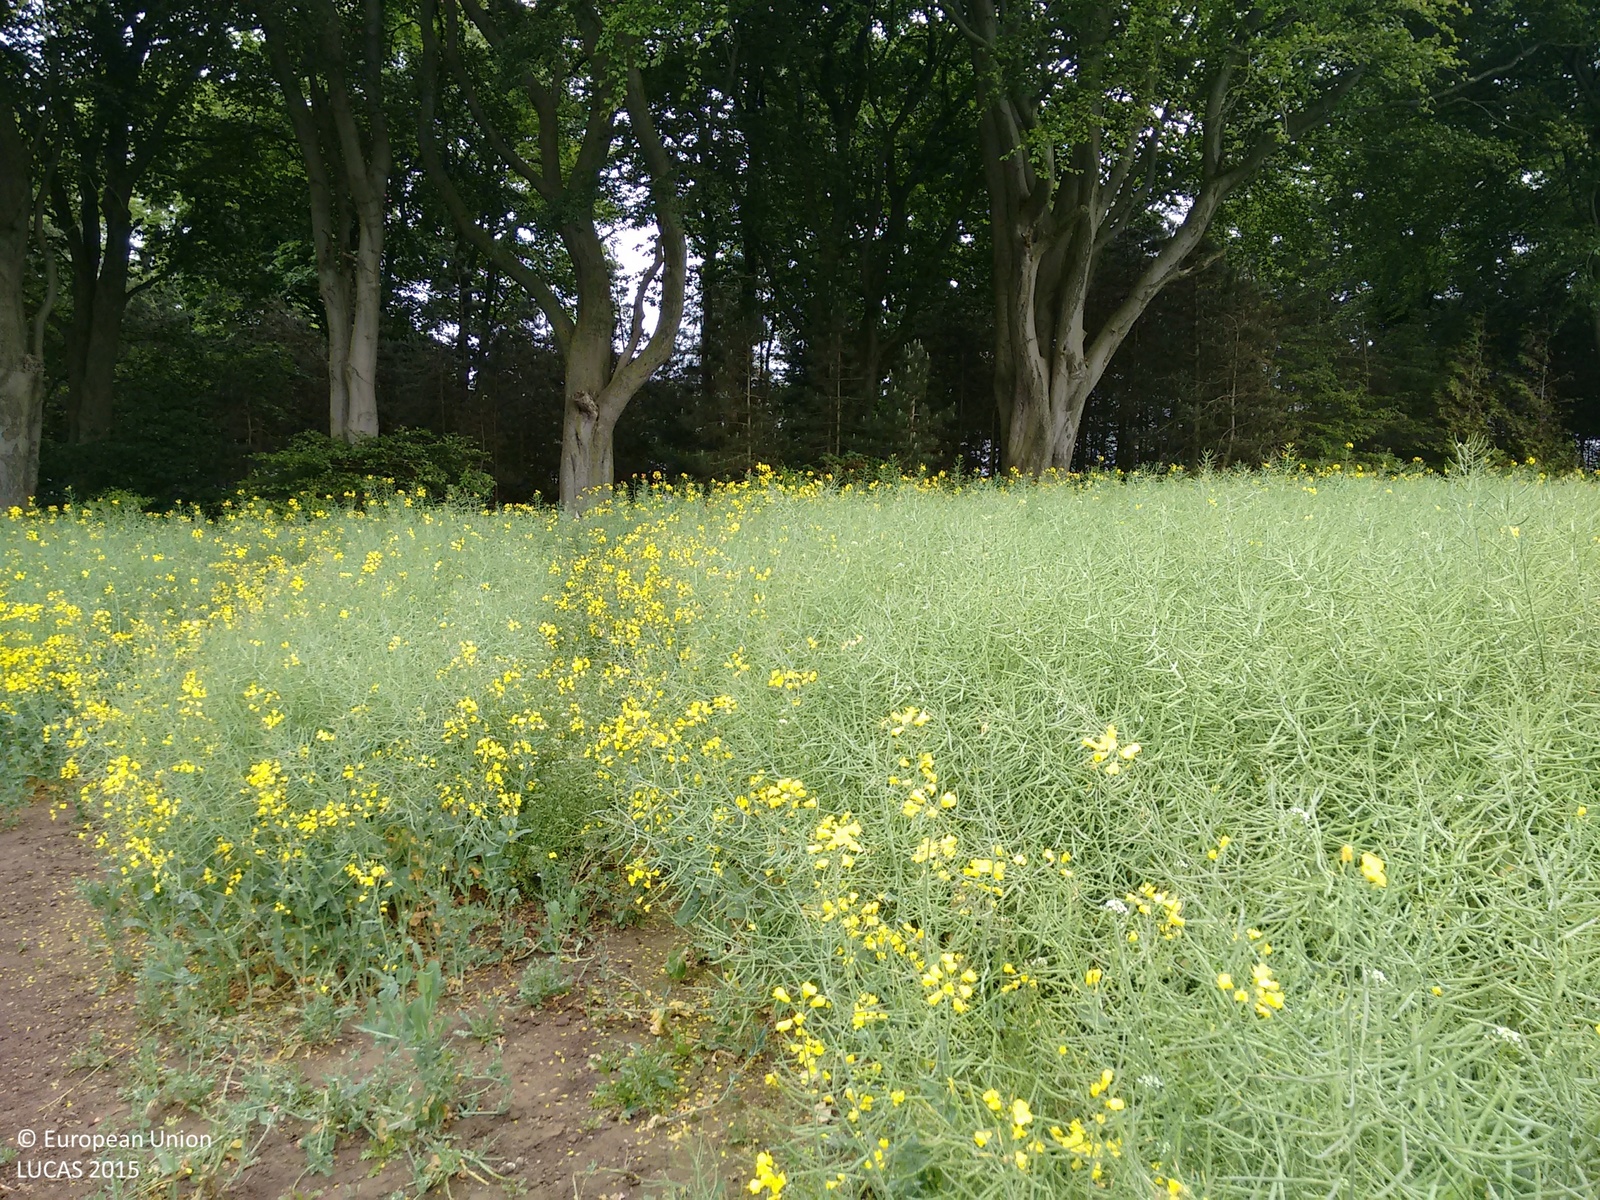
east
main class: Cropland
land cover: Rape and turnip rape
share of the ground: > 75 %
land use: Agriculture (excluding fallow land and kitchen gardens)
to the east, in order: Rape and turnip rape; Other mixed woodland; Common wheat
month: June
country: GB
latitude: 54.7031
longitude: -1.3276
